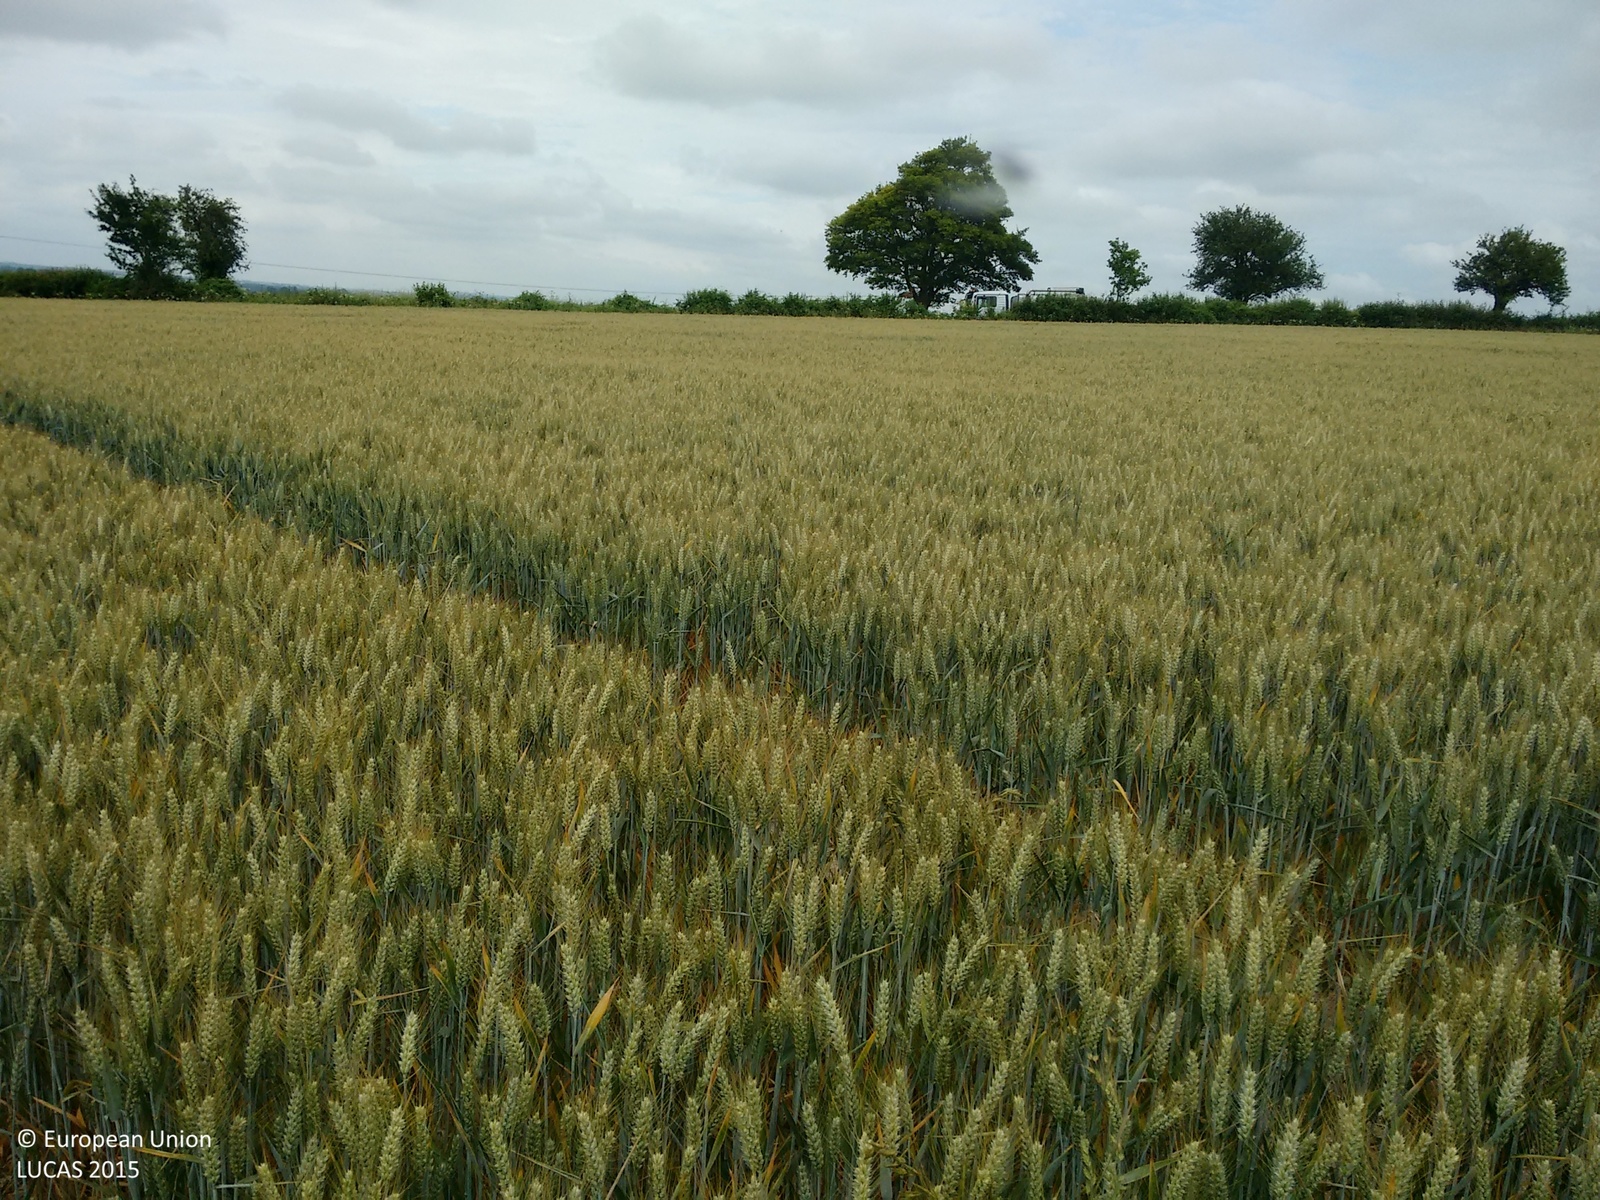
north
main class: Cropland
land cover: Common wheat
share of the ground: > 75 %
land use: Agriculture (excluding fallow land and kitchen gardens)
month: July
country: GB
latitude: 51.6019
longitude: -1.0906
